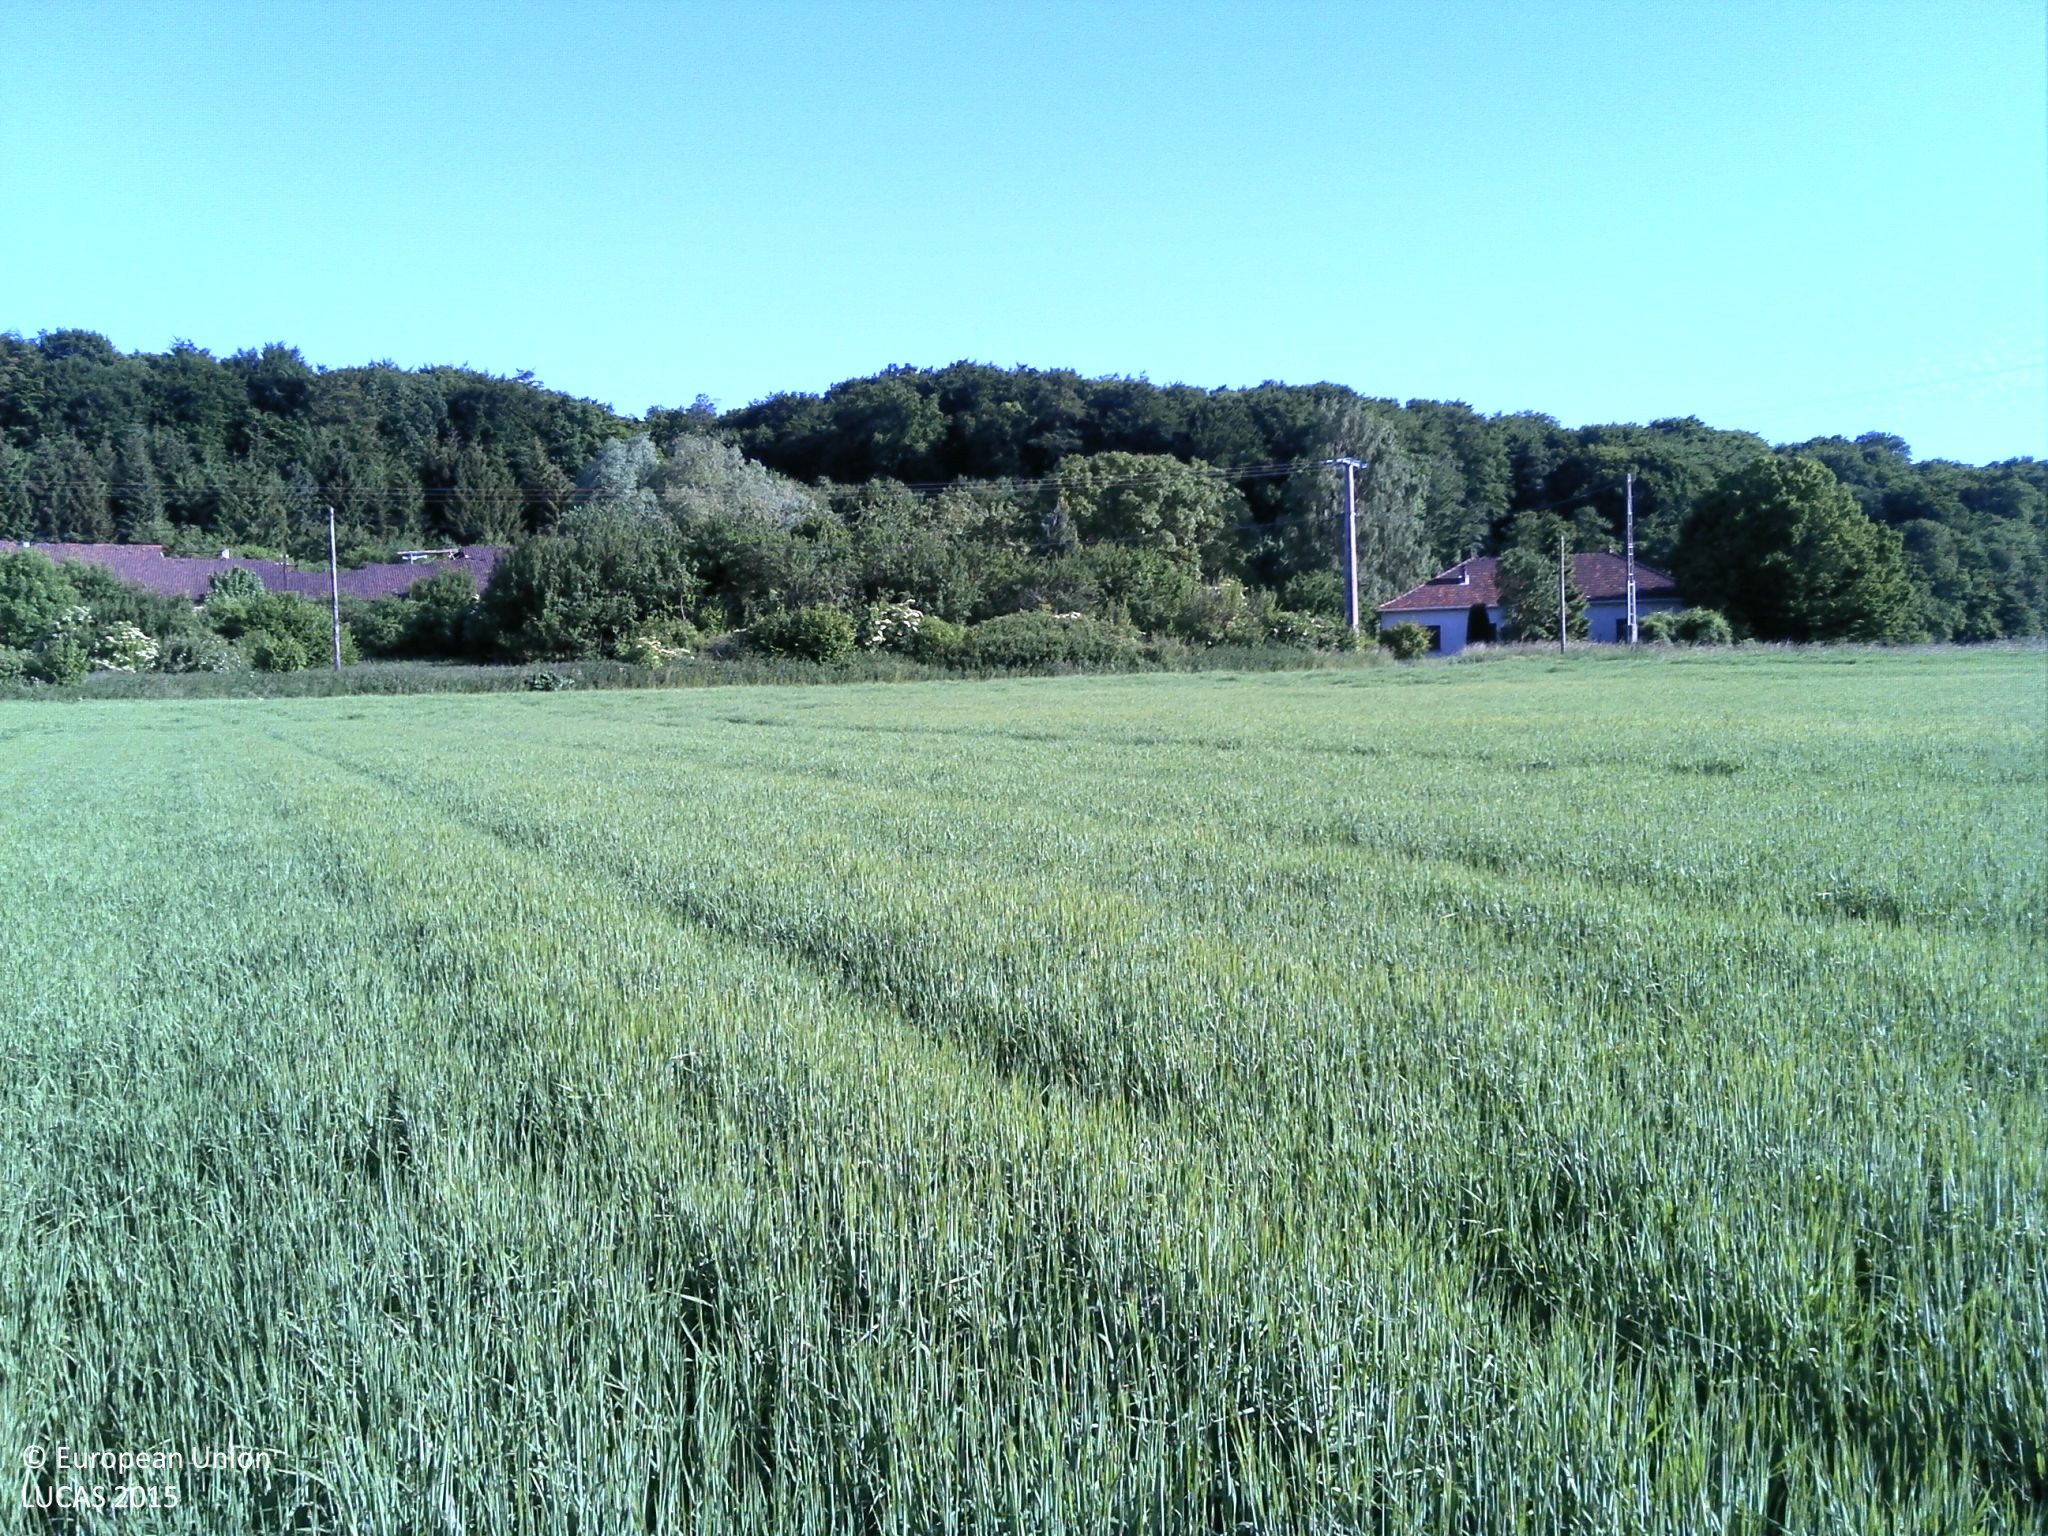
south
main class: Cropland
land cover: Barley
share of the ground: > 75 %
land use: Agriculture (excluding fallow land and kitchen gardens)
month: June
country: FR
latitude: 49.0504
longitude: 5.9631
